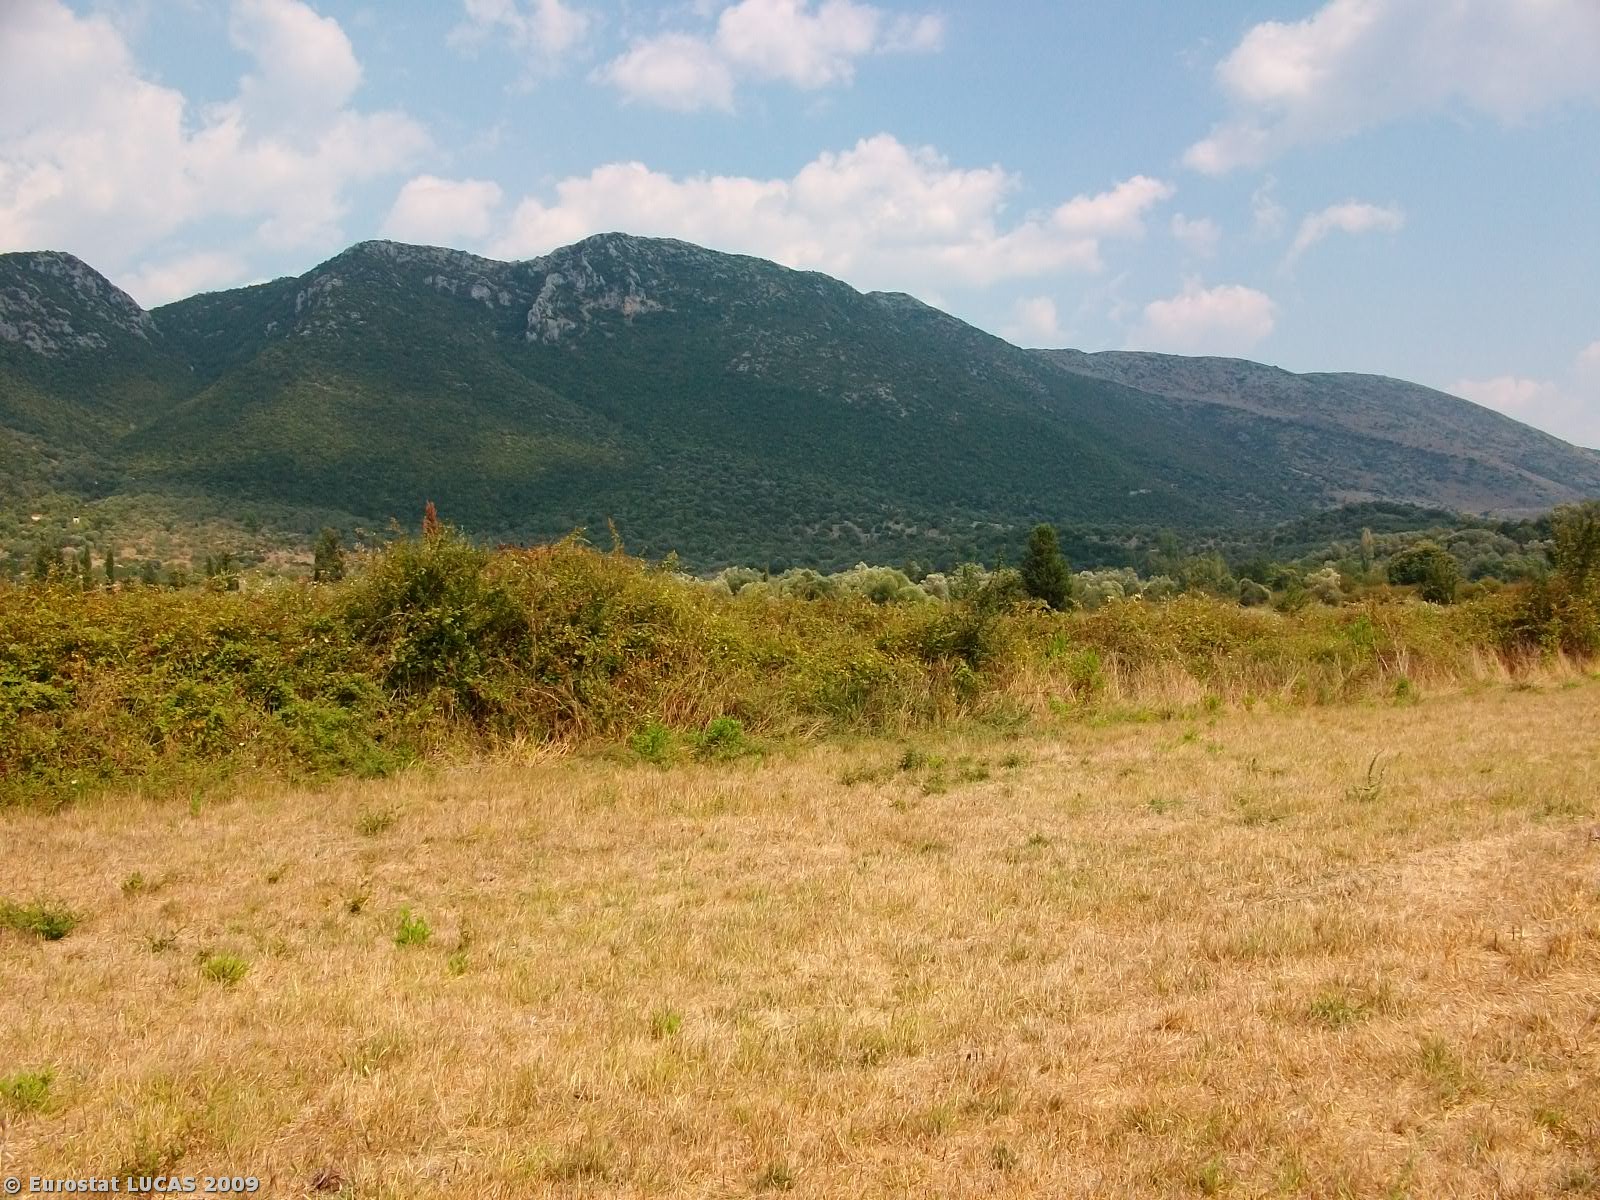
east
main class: Grassland
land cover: Grassland with sparse tree/shrub cover
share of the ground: > 75 %
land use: Agriculture (excluding fallow land and kitchen gardens)
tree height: < 5 m
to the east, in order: Grassland with sparse tree/shrub cover; Abandoned hedges; Fences; Grassland without tree/shrub cover; Fences; Abandoned hedges; Grassland without tree/shrub cover; Abandoned hedges; Spontaneously vegetated surfaces; Grass margins; Paved roads, cycling and walking lanes; Grass margins; Fences; Olive groves; Grassland with sparse tree/shrub cover
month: August
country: GR
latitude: 39.3837
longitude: 20.4104
